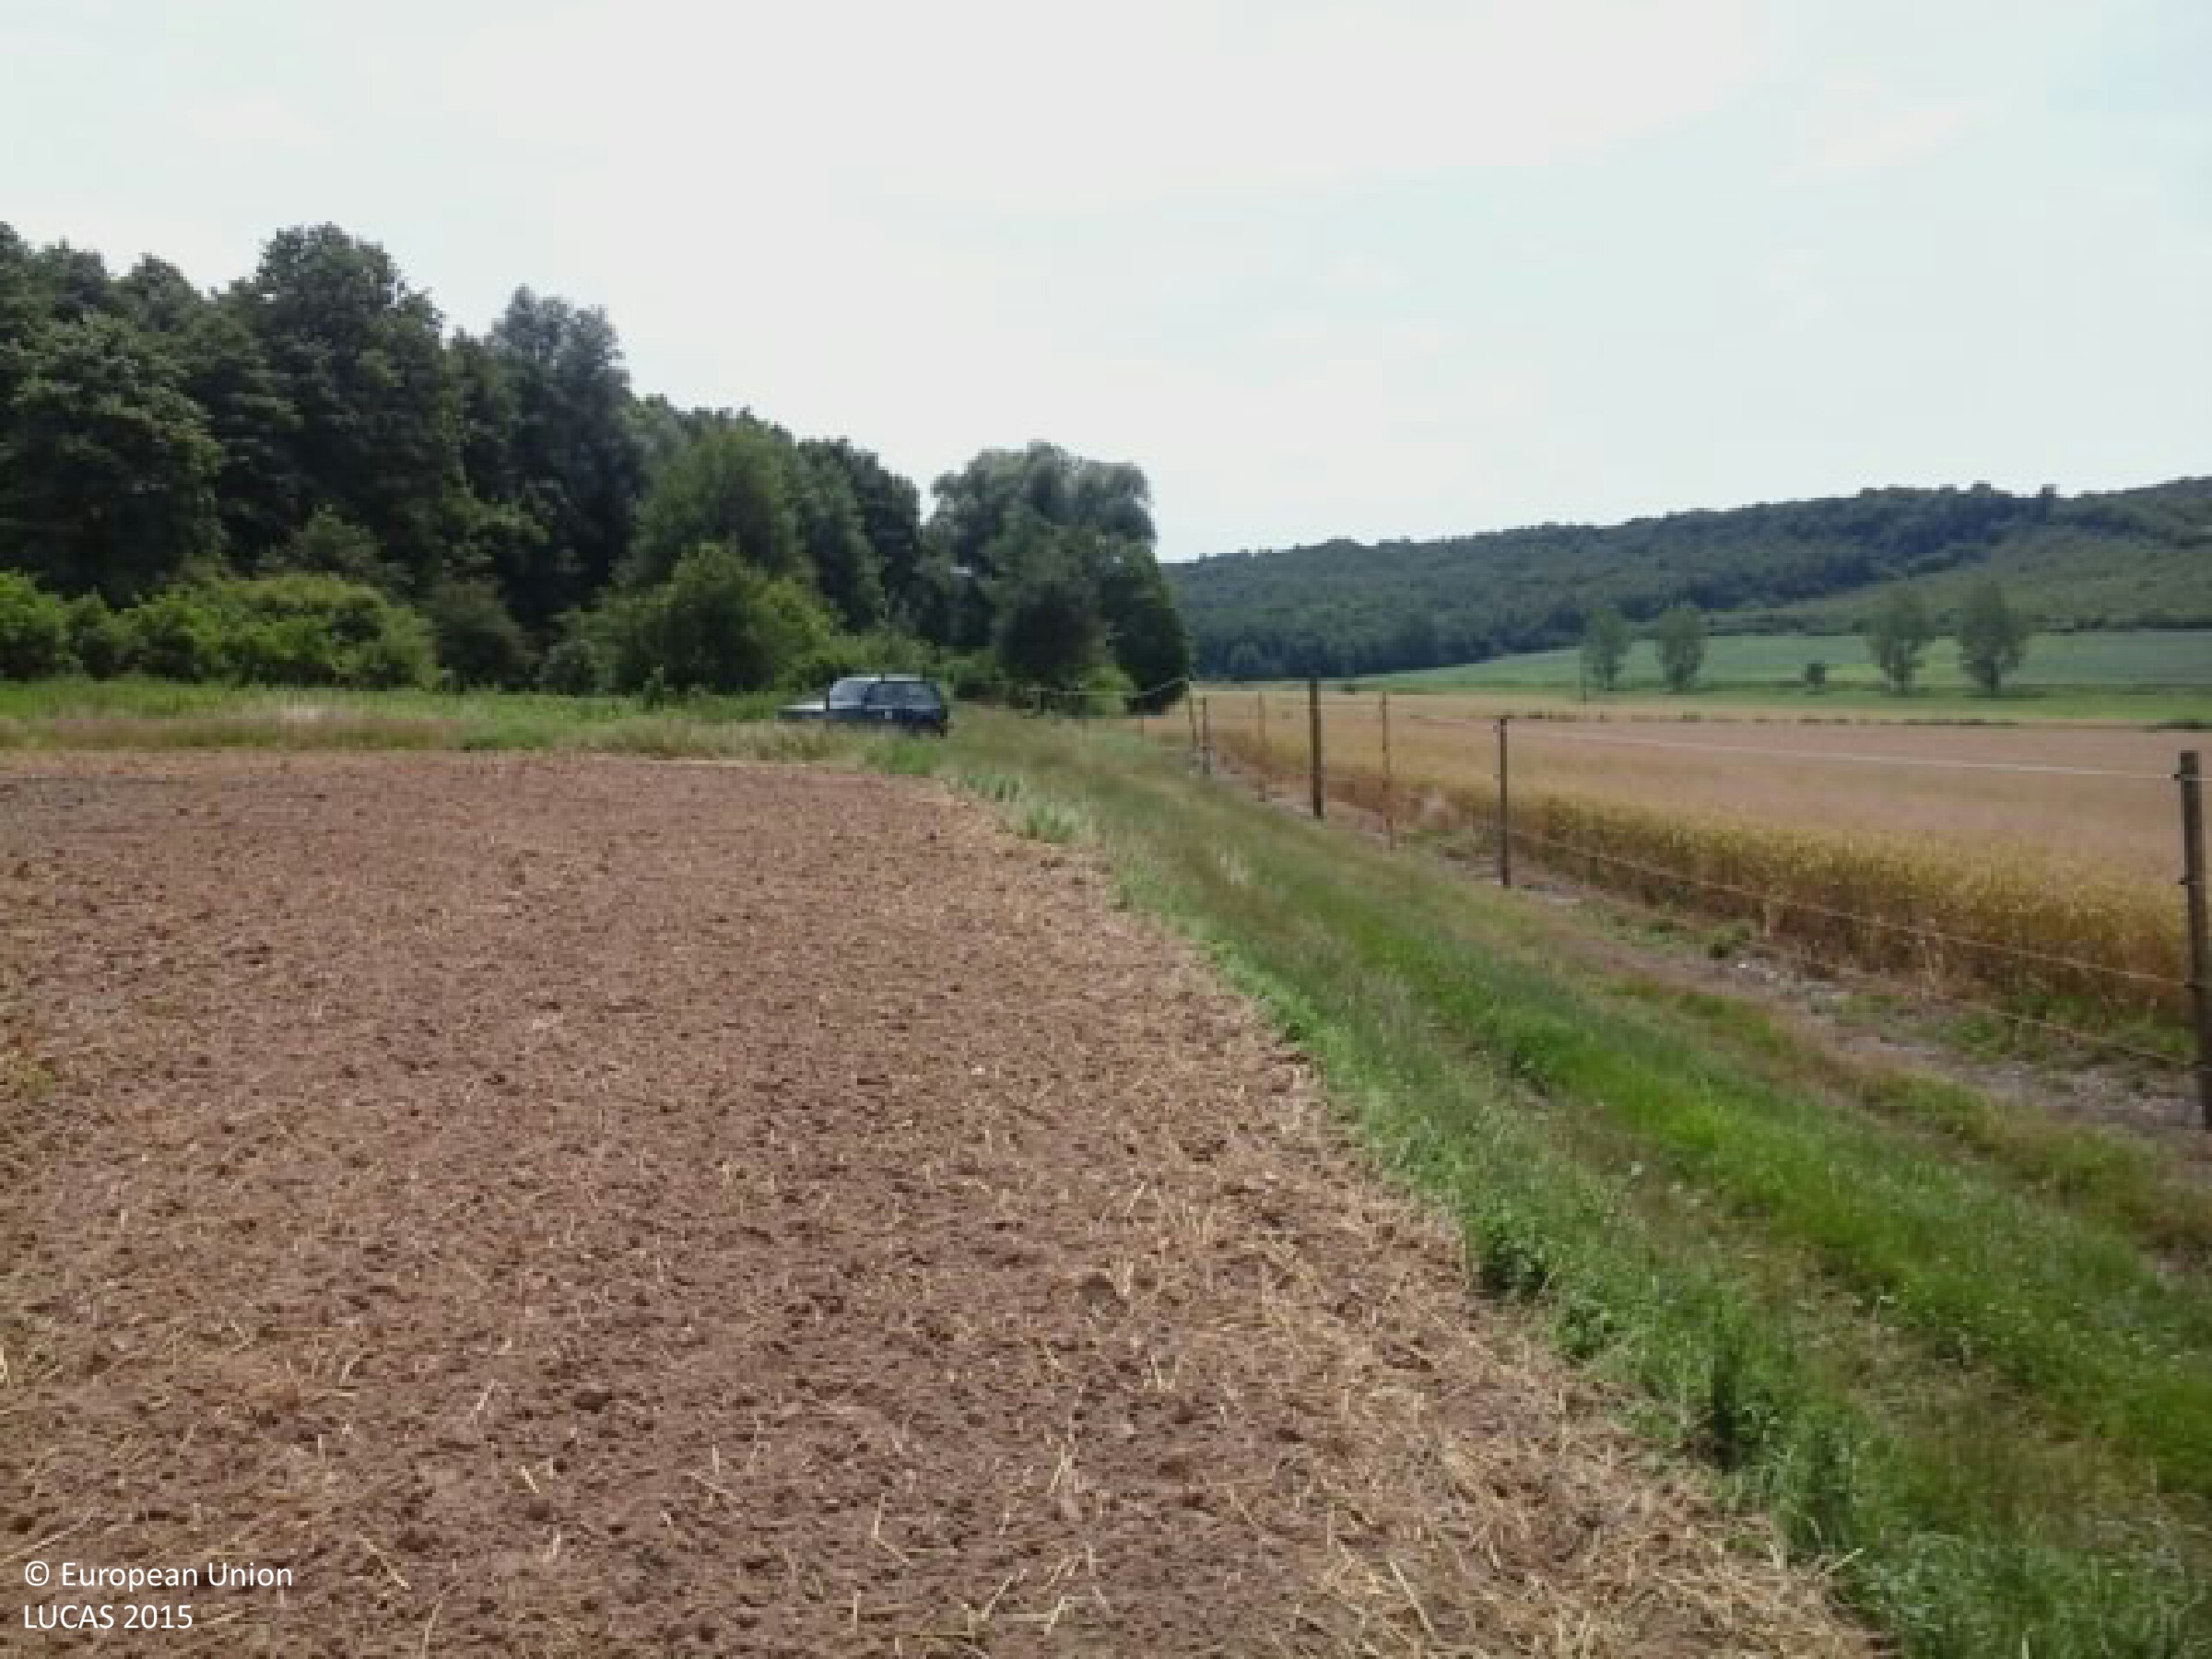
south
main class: Cropland
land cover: Common wheat
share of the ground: < 10 %
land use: Agriculture (excluding fallow land and kitchen gardens)
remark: Harvested field
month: June
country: HU
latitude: 46.2950
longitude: 17.8859
